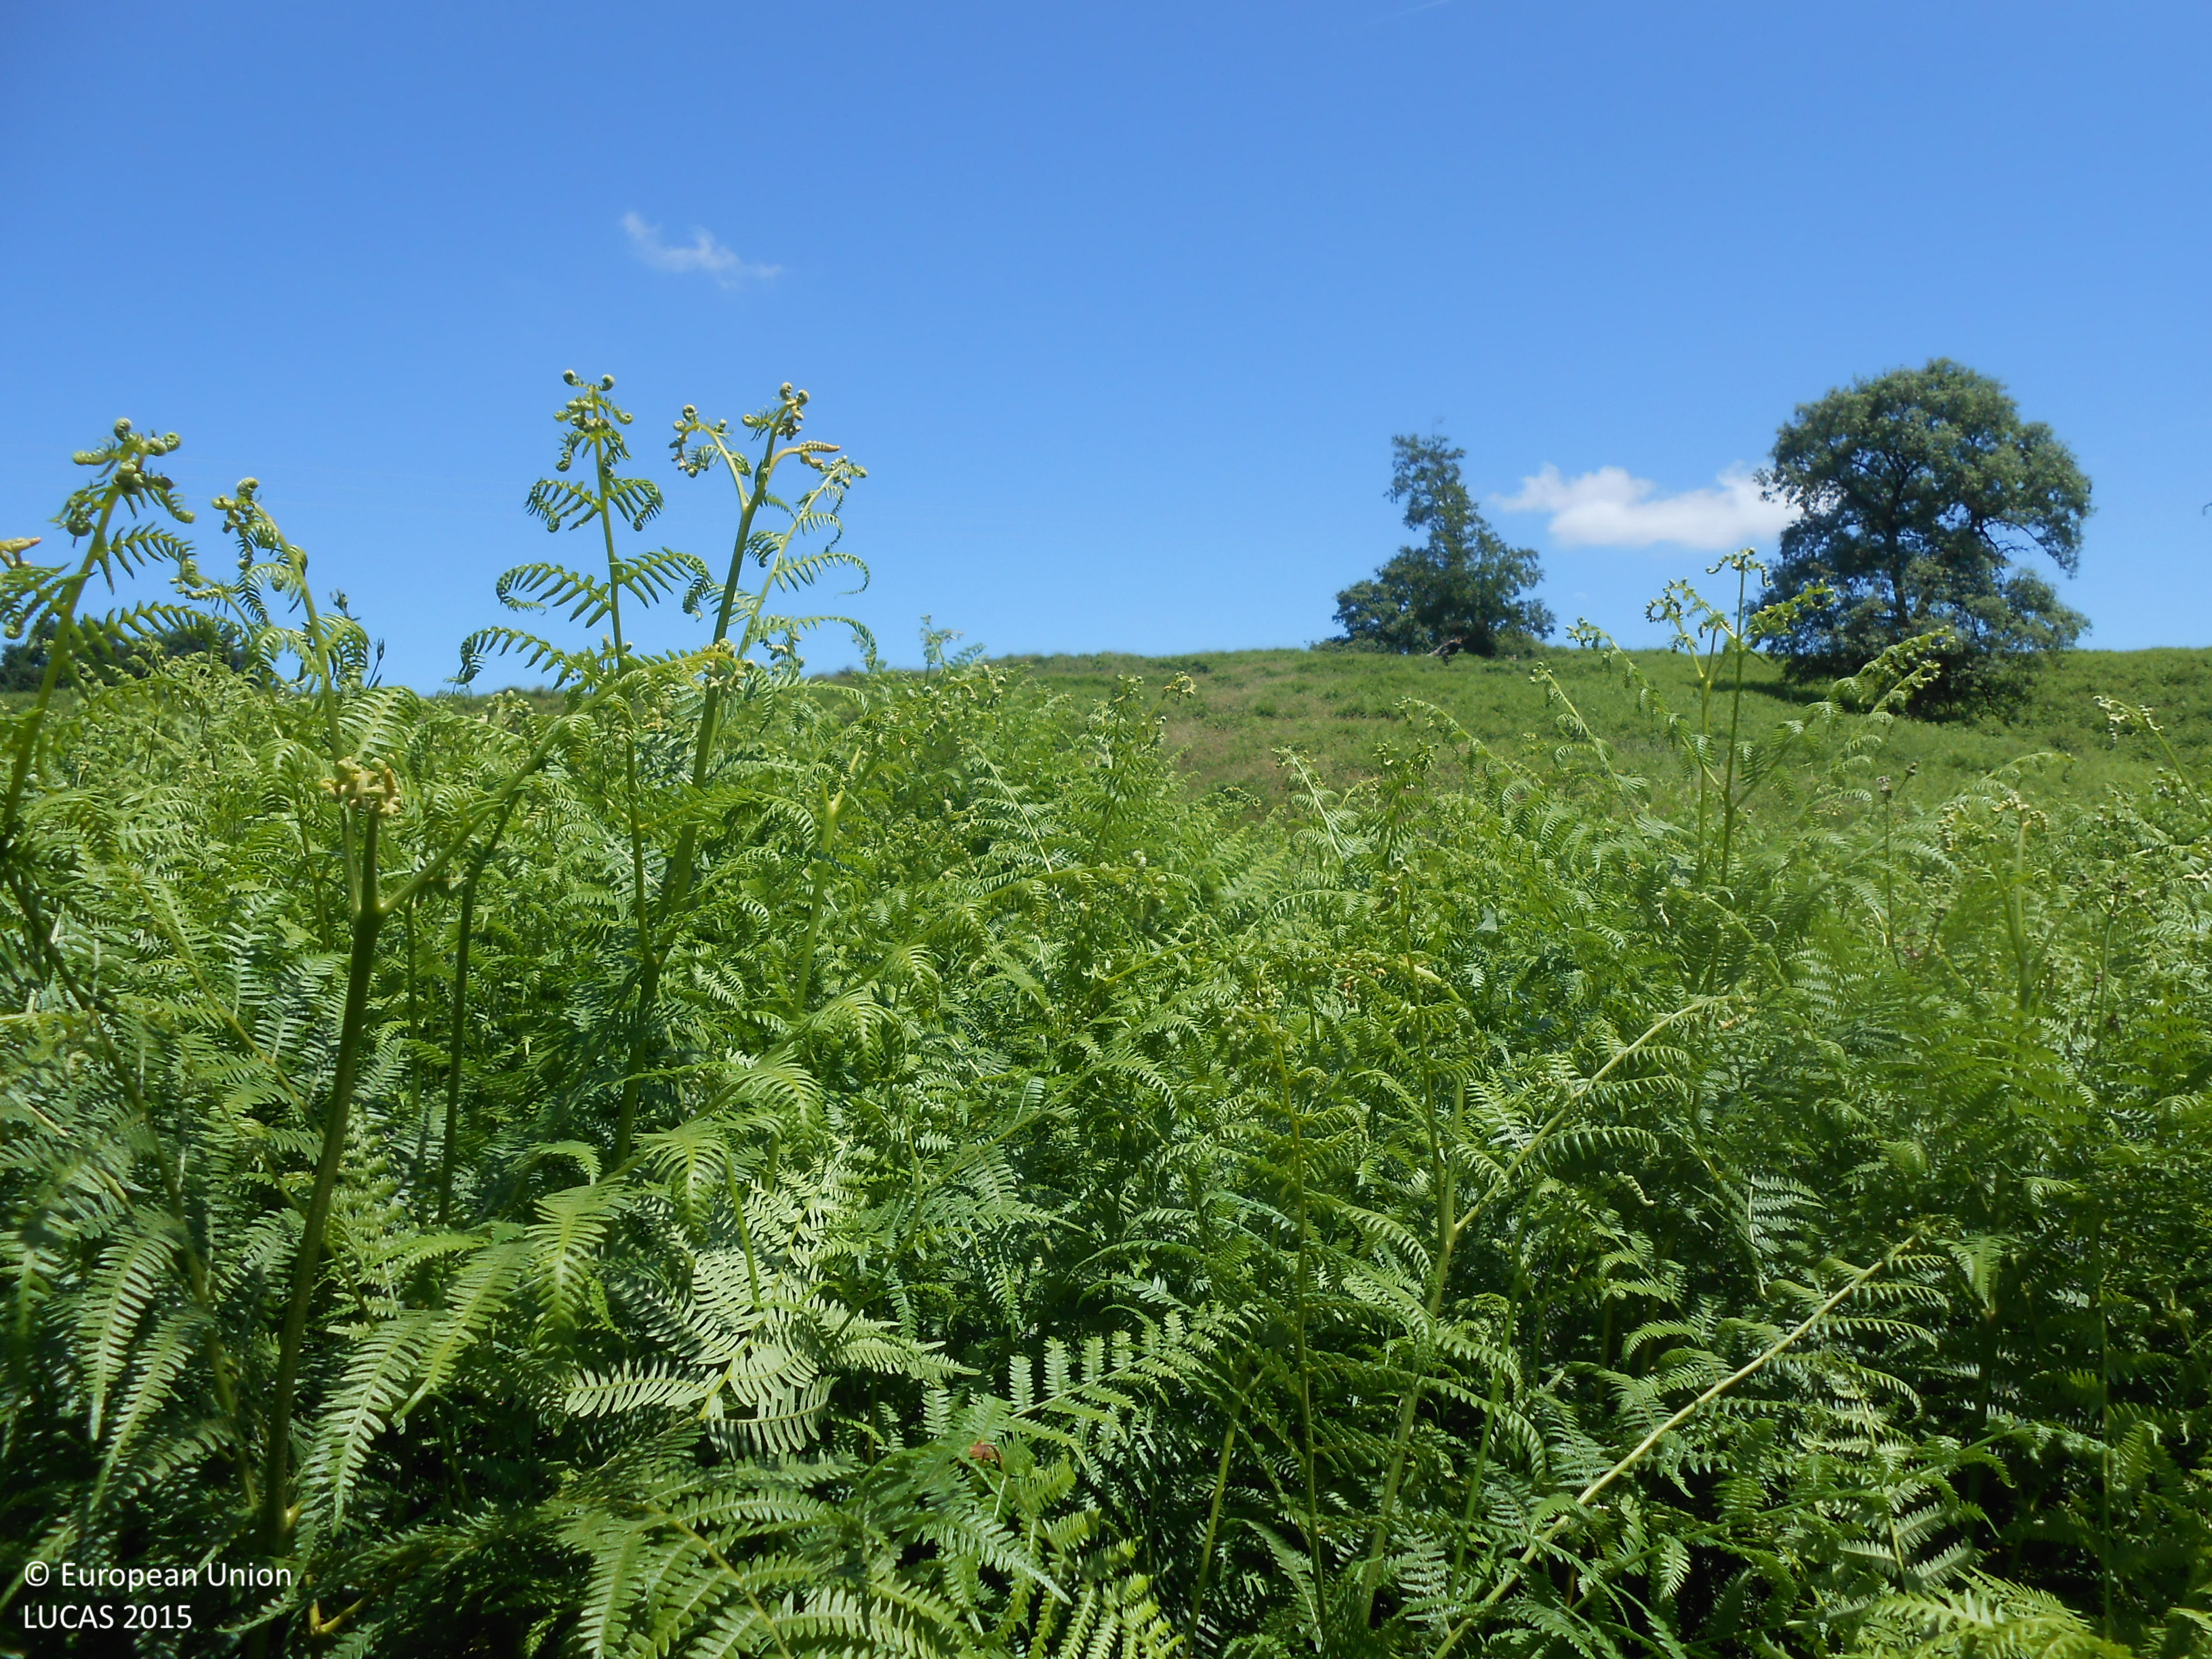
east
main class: Grassland
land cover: Grassland without tree/shrub cover
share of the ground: > 75 %
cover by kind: herbaceous plants 100 %
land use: Agriculture (excluding fallow land and kitchen gardens)
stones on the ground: < 10 %
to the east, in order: Grassland without tree/shrub cover; Electric lines; Grassland without tree/shrub cover; Fences; Tracks; Fences; Groves; Grassland without tree/shrub cover
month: June
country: ES
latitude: 43.0056
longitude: -1.7577
